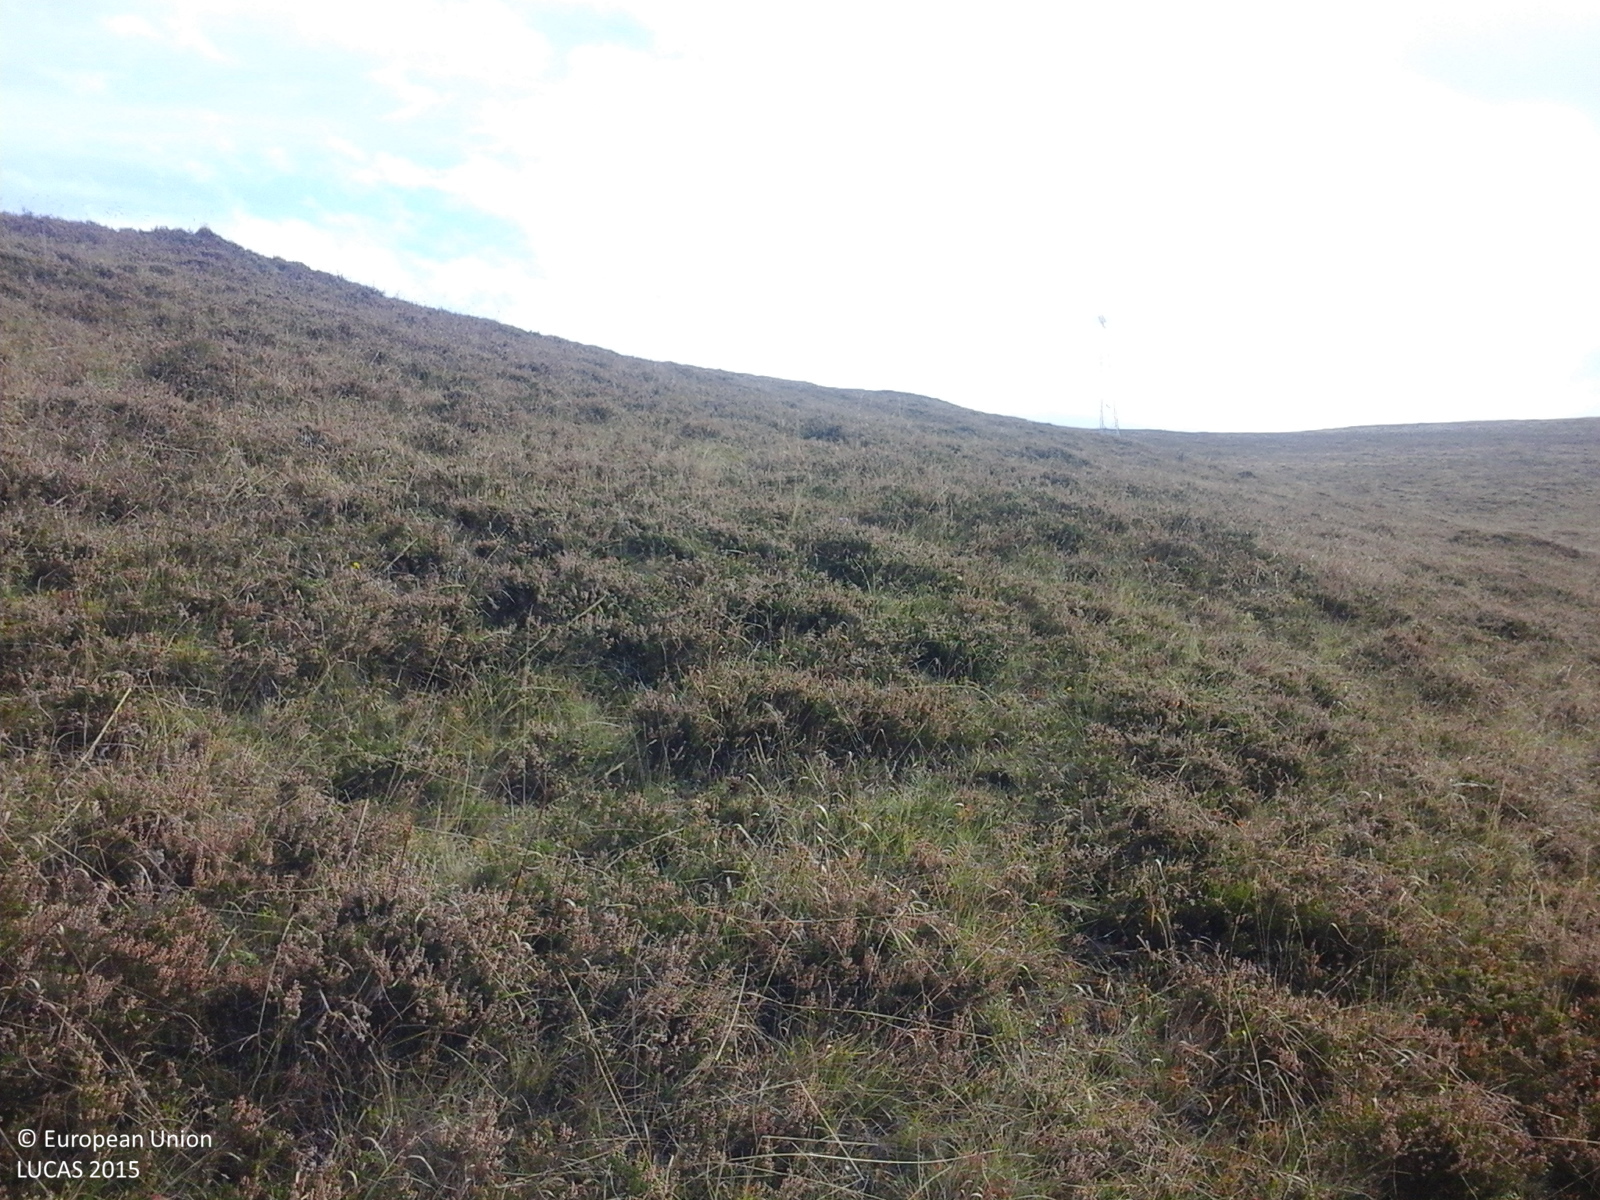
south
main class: Grassland
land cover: Grassland without tree/shrub cover
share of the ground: > 75 %
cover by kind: herbaceous plants 100 %
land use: Agriculture (excluding fallow land and kitchen gardens)
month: October
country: RO
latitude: 46.6922
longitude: 23.2322
